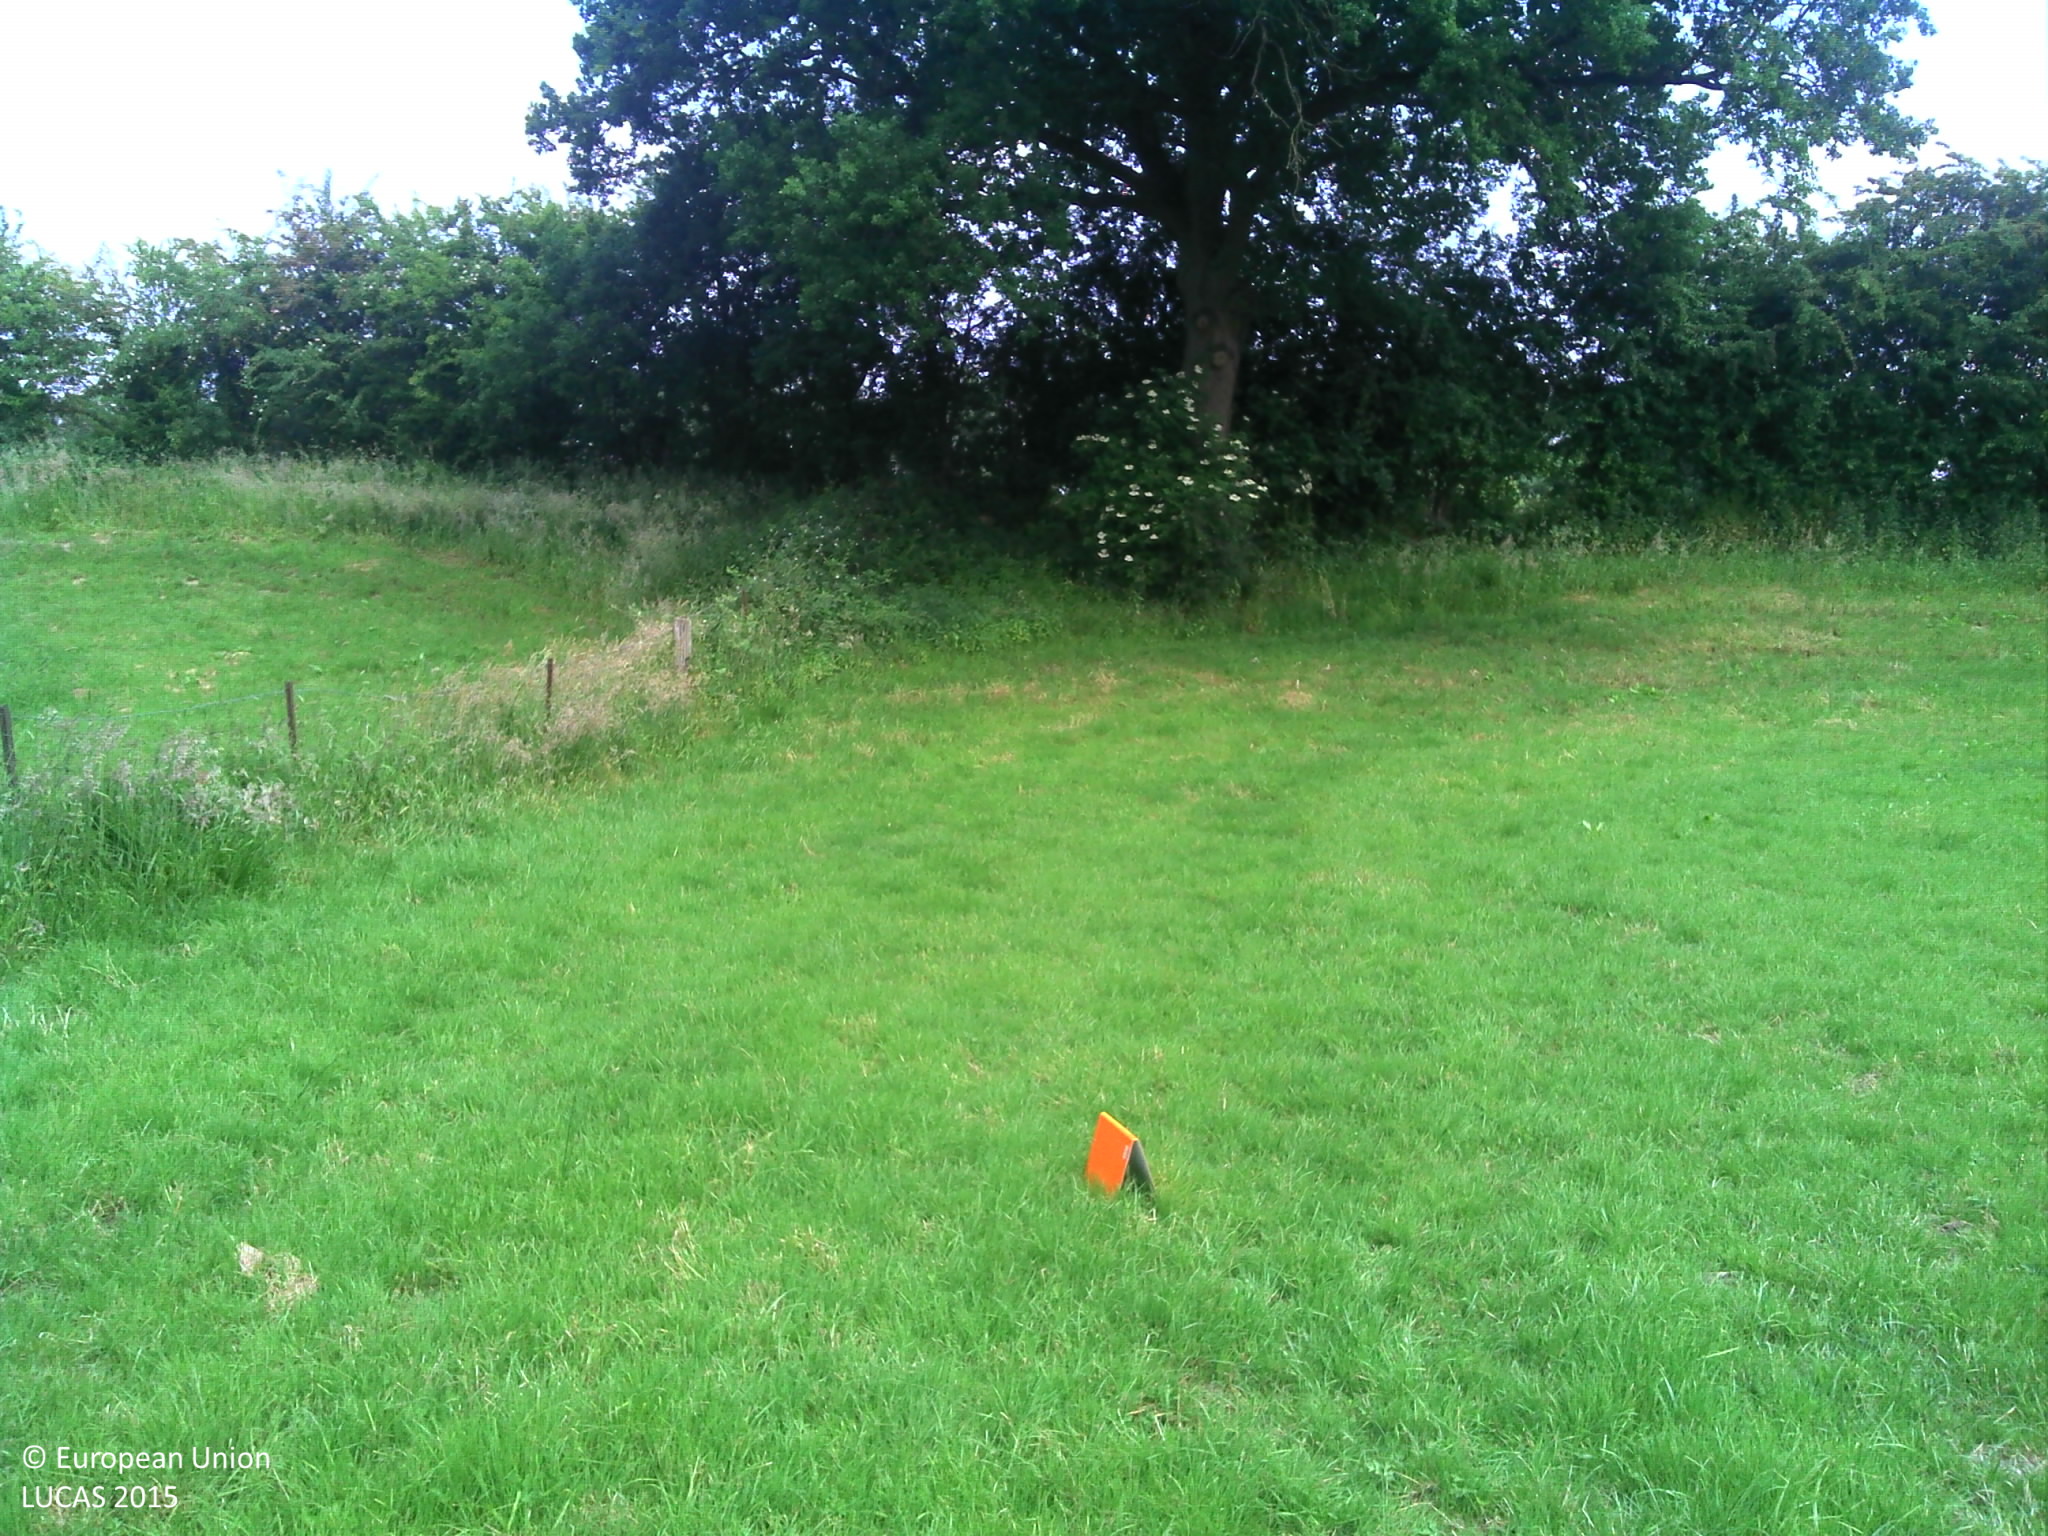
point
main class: Grassland
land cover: Grassland without tree/shrub cover
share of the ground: > 75 %
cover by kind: herbaceous plants 100 %
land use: Agriculture (excluding fallow land and kitchen gardens)
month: June
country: FR
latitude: 49.9370
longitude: 4.0173
